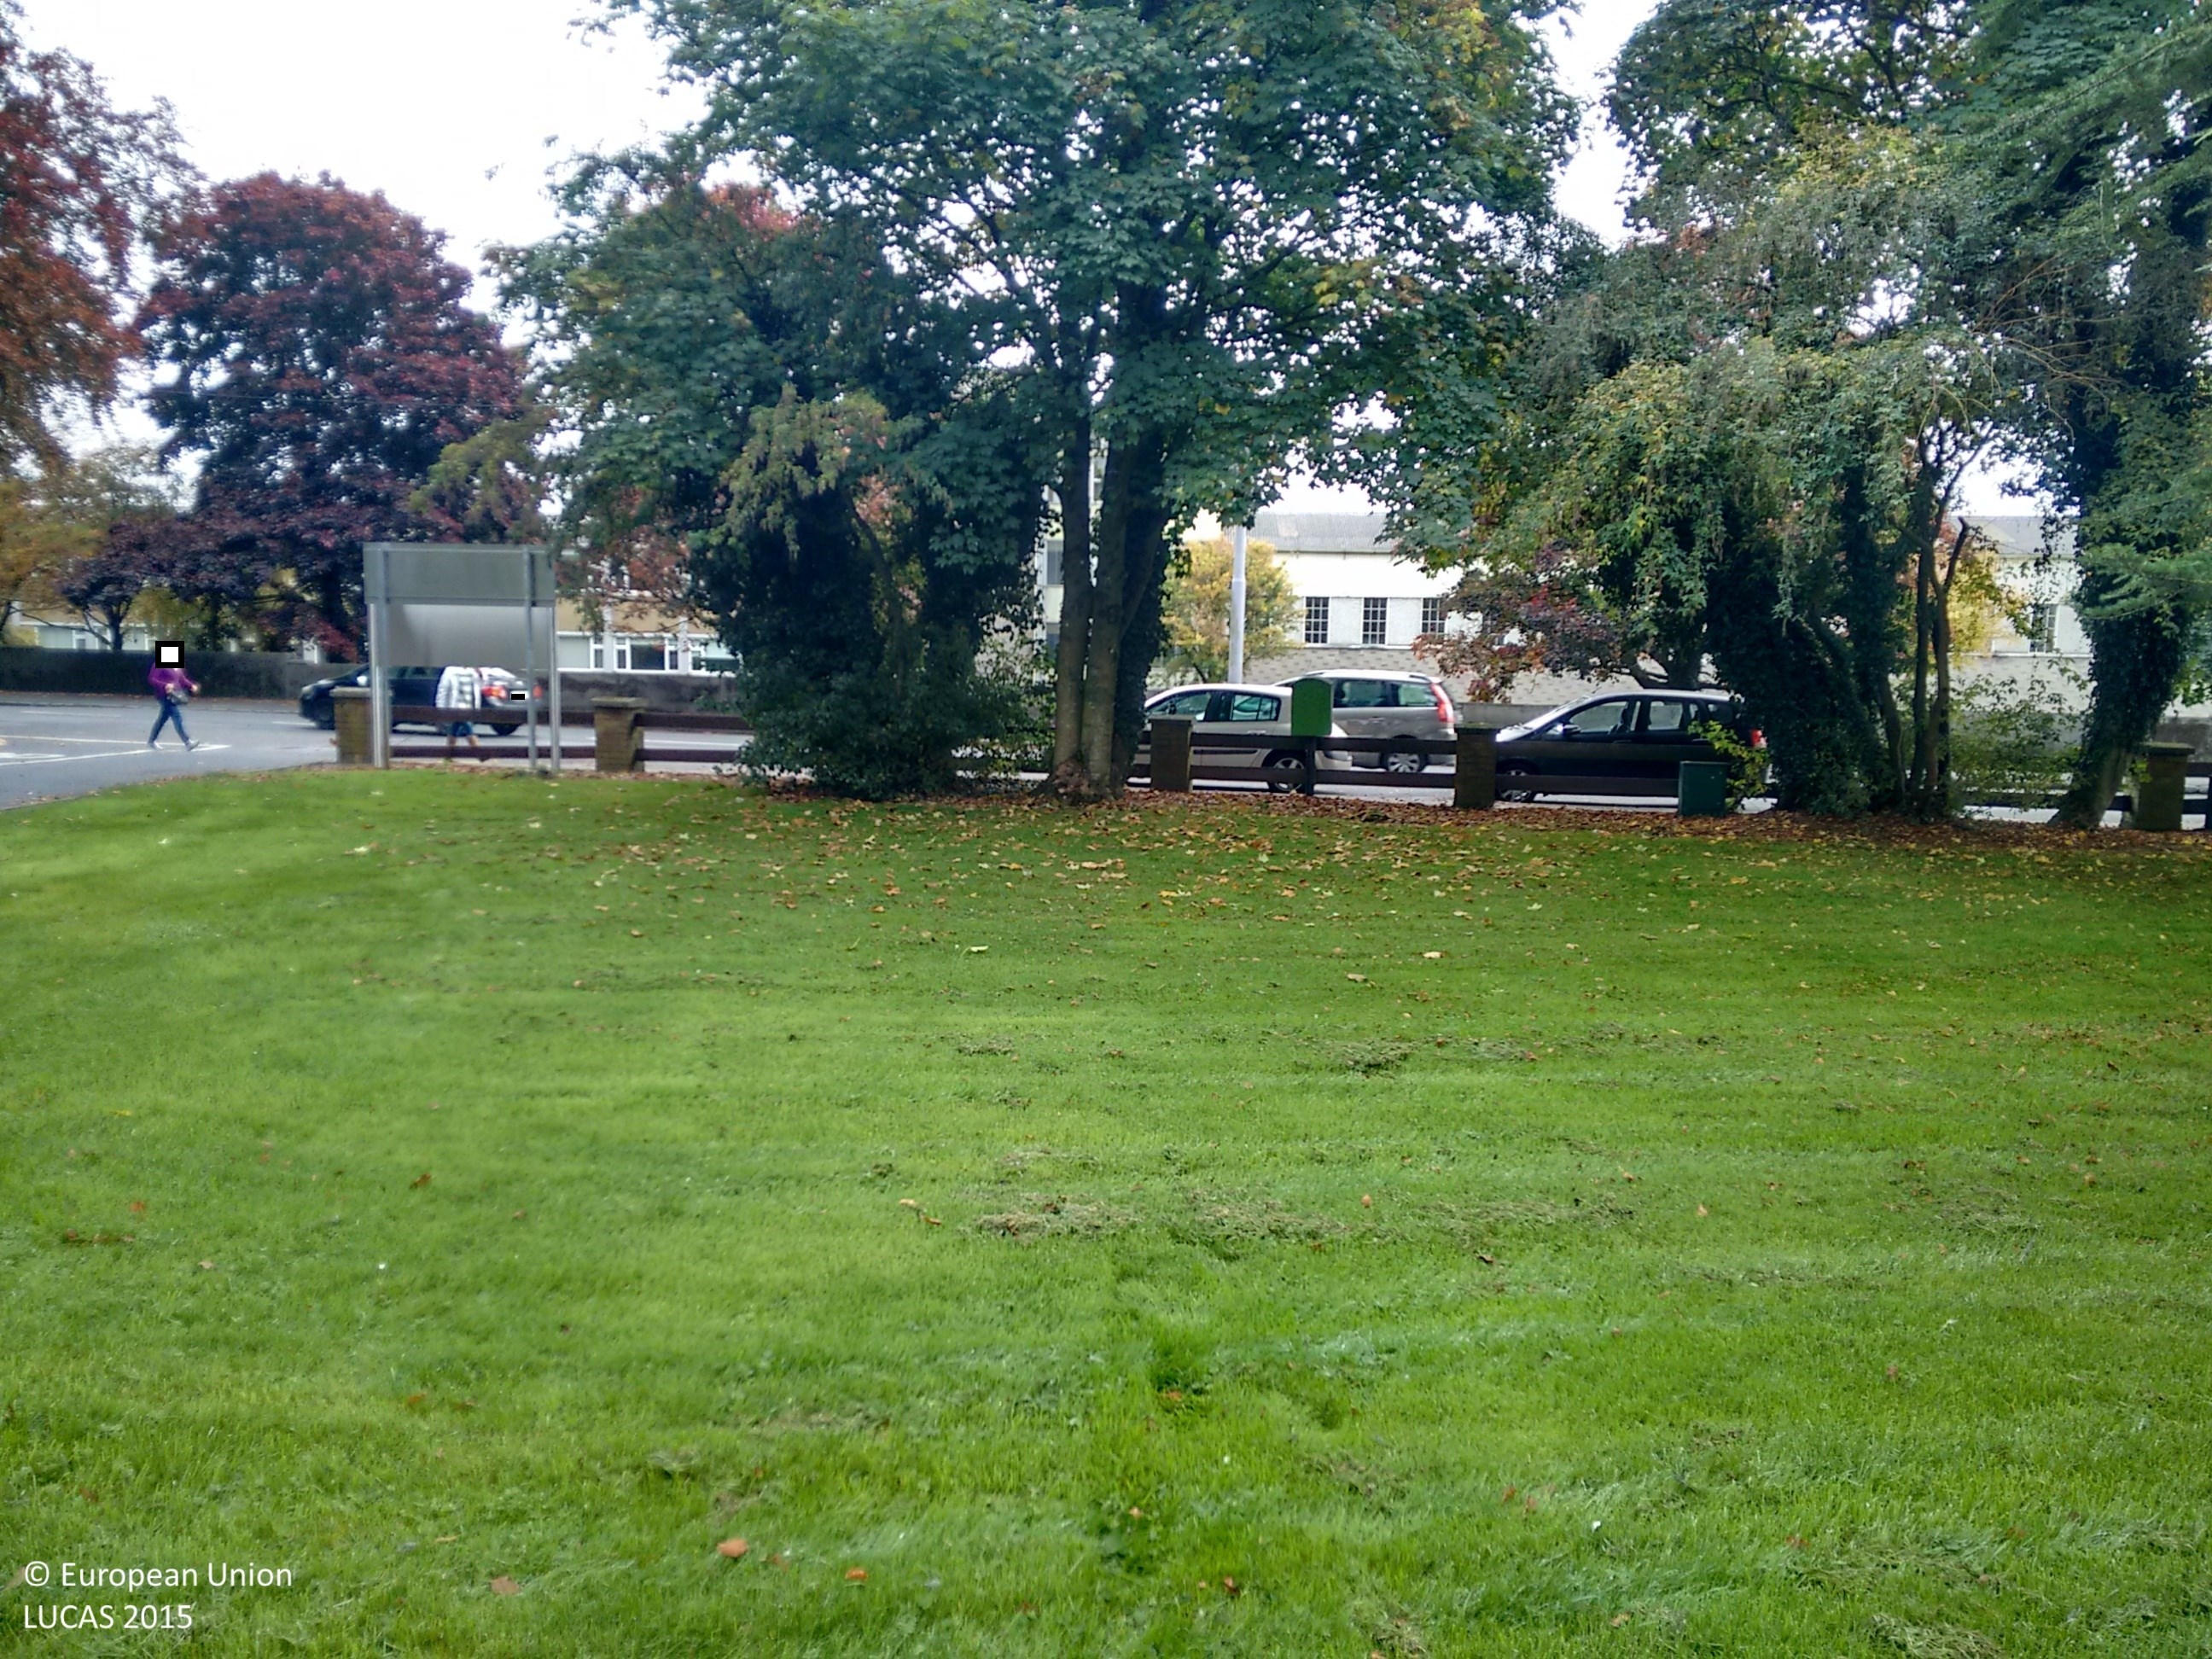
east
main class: Grassland
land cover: Grassland with sparse tree/shrub cover
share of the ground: > 75 %
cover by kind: herbaceous plants 95 %, broadleaved forest trees 5 %
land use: Community services
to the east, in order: Grassland with sparse tree/shrub cover; Lines of trees; Fences; Artificial constructions in urban areas; Grassland with sparse tree/shrub cover; Artificial constructions in urban areas; Rivers and streams; Broadleaved woodland; Grassland without tree/shrub cover
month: October
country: IE
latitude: 52.6737
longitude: -7.8130
